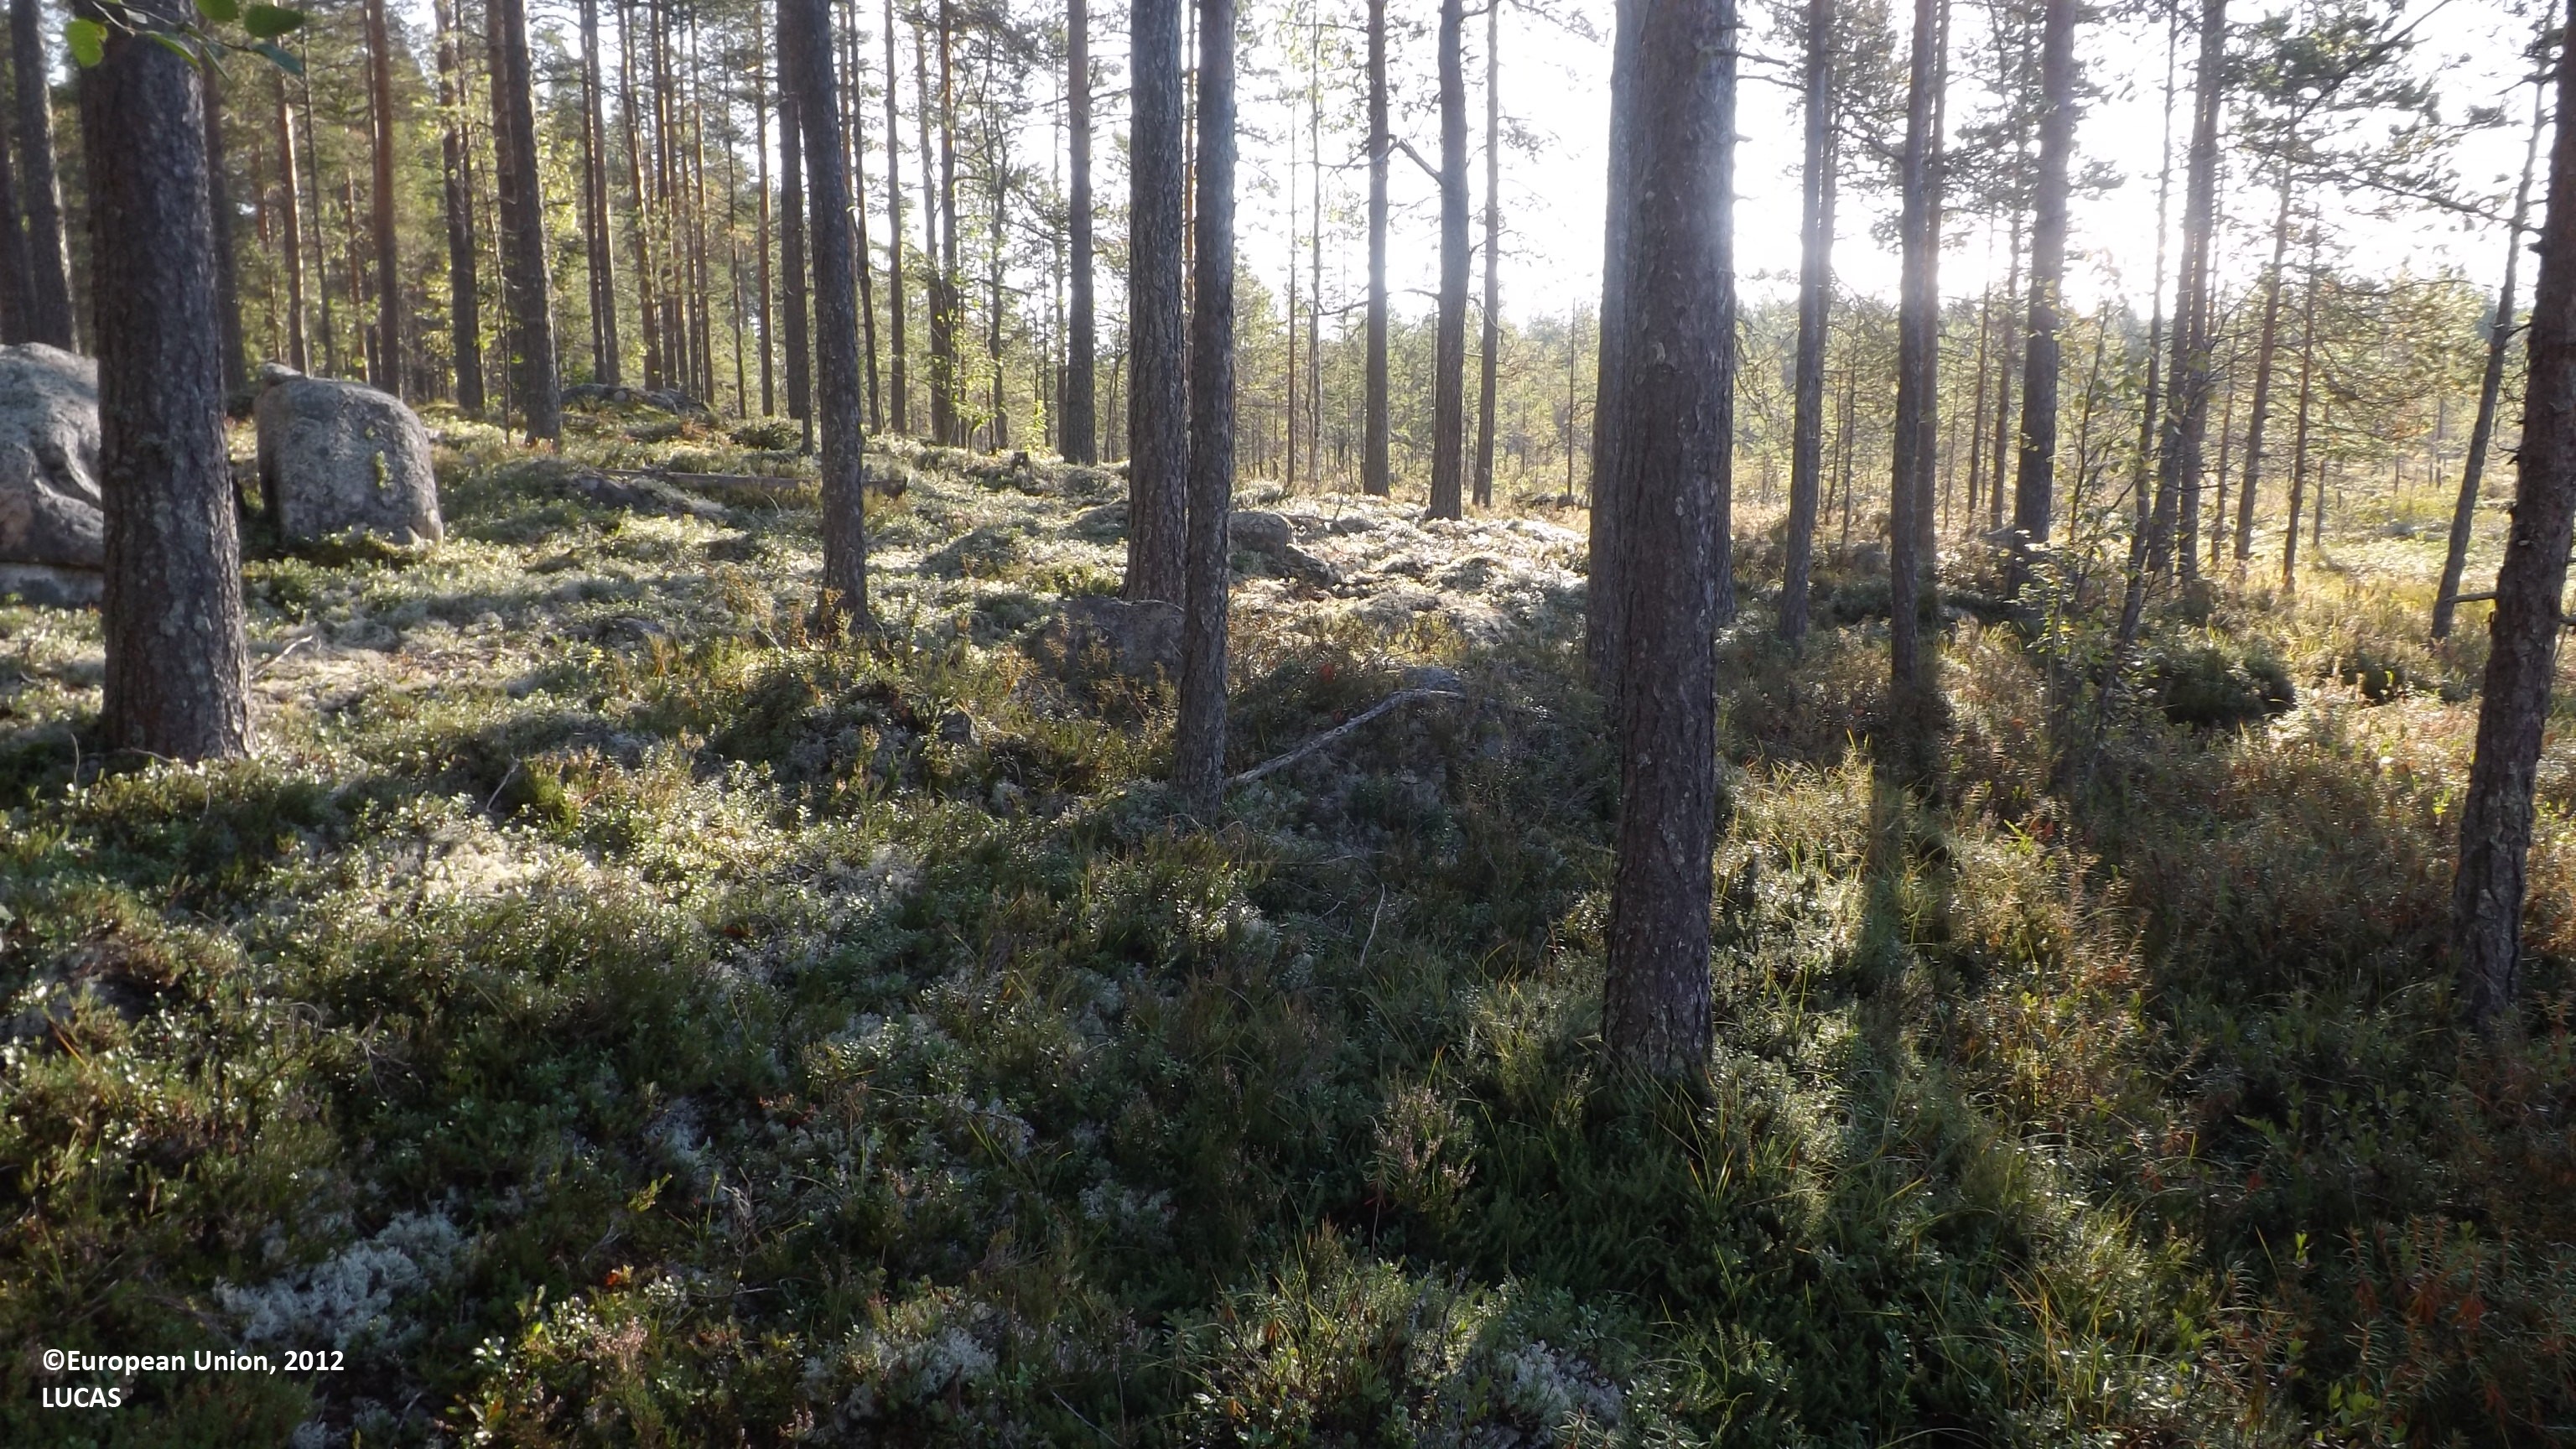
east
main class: Woodland
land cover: Pine dominated coniferous woodland
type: boreal forest
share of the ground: 25 - 50 %
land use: Forestry
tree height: > 5 m
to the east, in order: Pine dominated coniferous woodland; Peatbogs; Pine dominated coniferous woodland; Ditches and canals; Pine dominated coniferous woodland; Ditches and canals; Pine dominated mixed woodland; Ditches and canals; Pine dominated coniferous woodland; Ditches and canals; Pine dominated mixed woodland; Broadleaved woodland
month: August
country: FI
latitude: 63.7486
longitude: 24.0718
